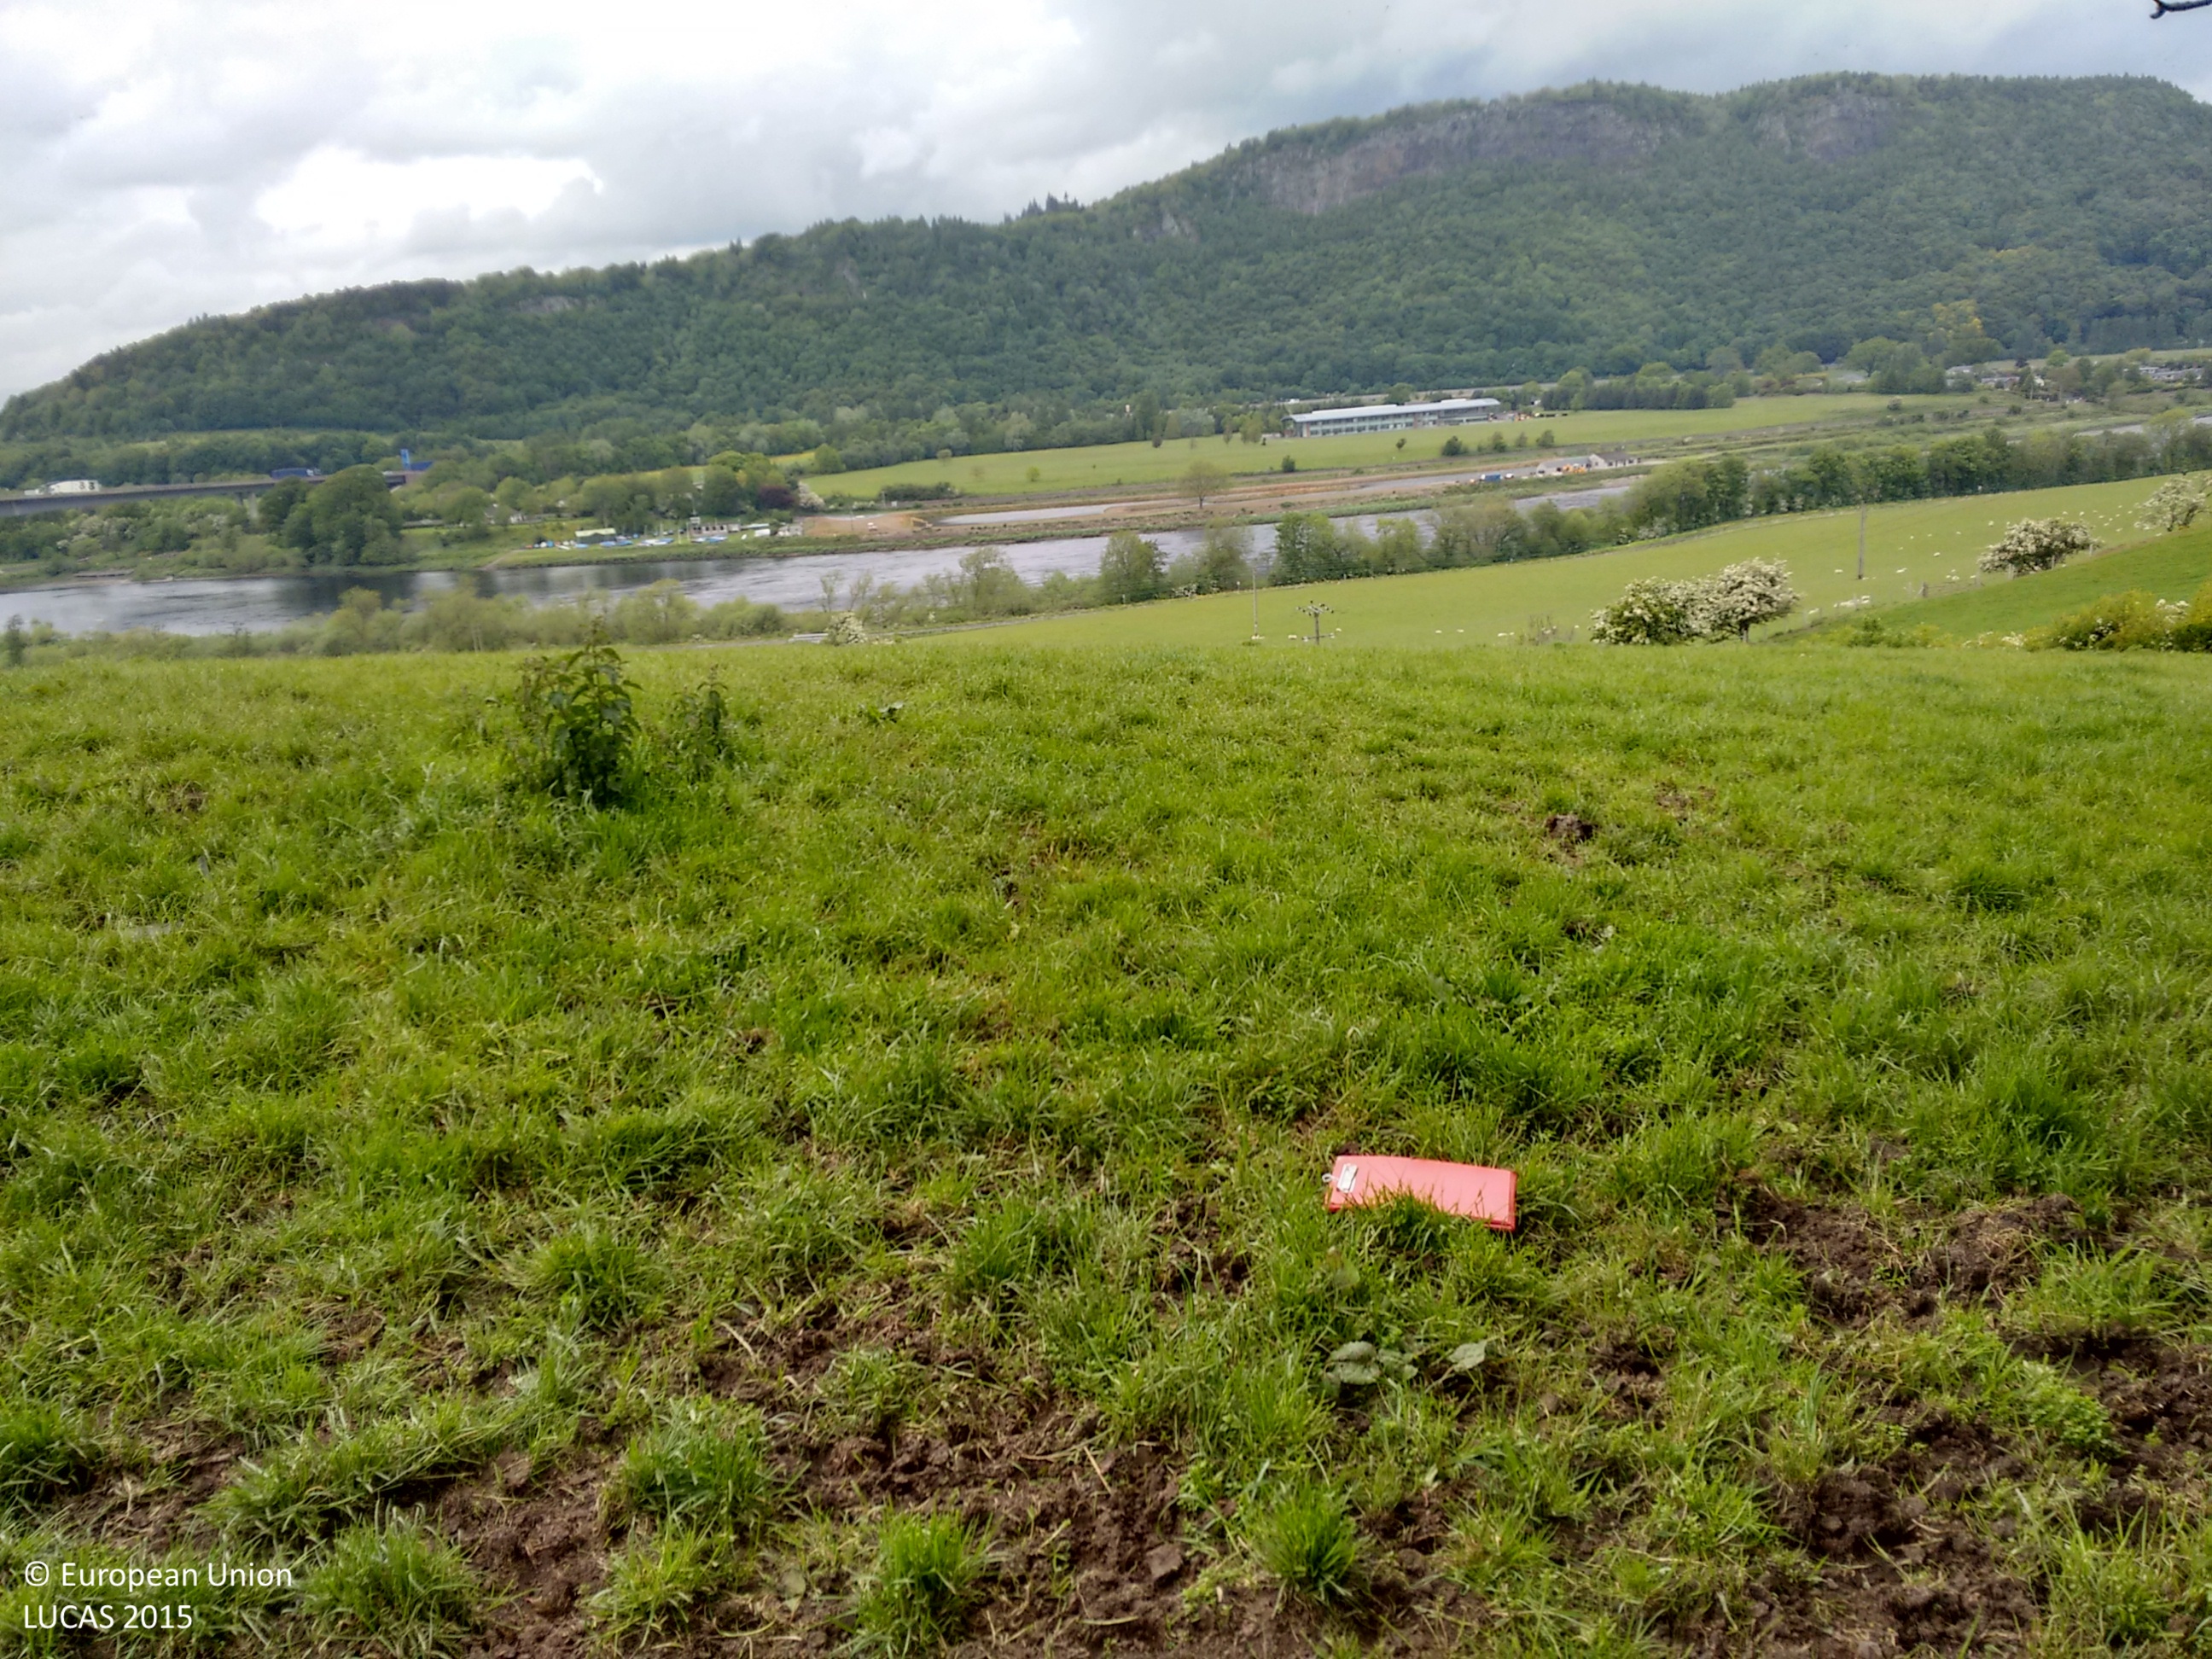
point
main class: Grassland
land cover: Grassland without tree/shrub cover
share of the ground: > 75 %
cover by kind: herbaceous plants 90 %, unconsolidated bare surface 10 %
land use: Agriculture (excluding fallow land and kitchen gardens)
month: June
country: GB
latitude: 56.3753
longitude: -3.3999
